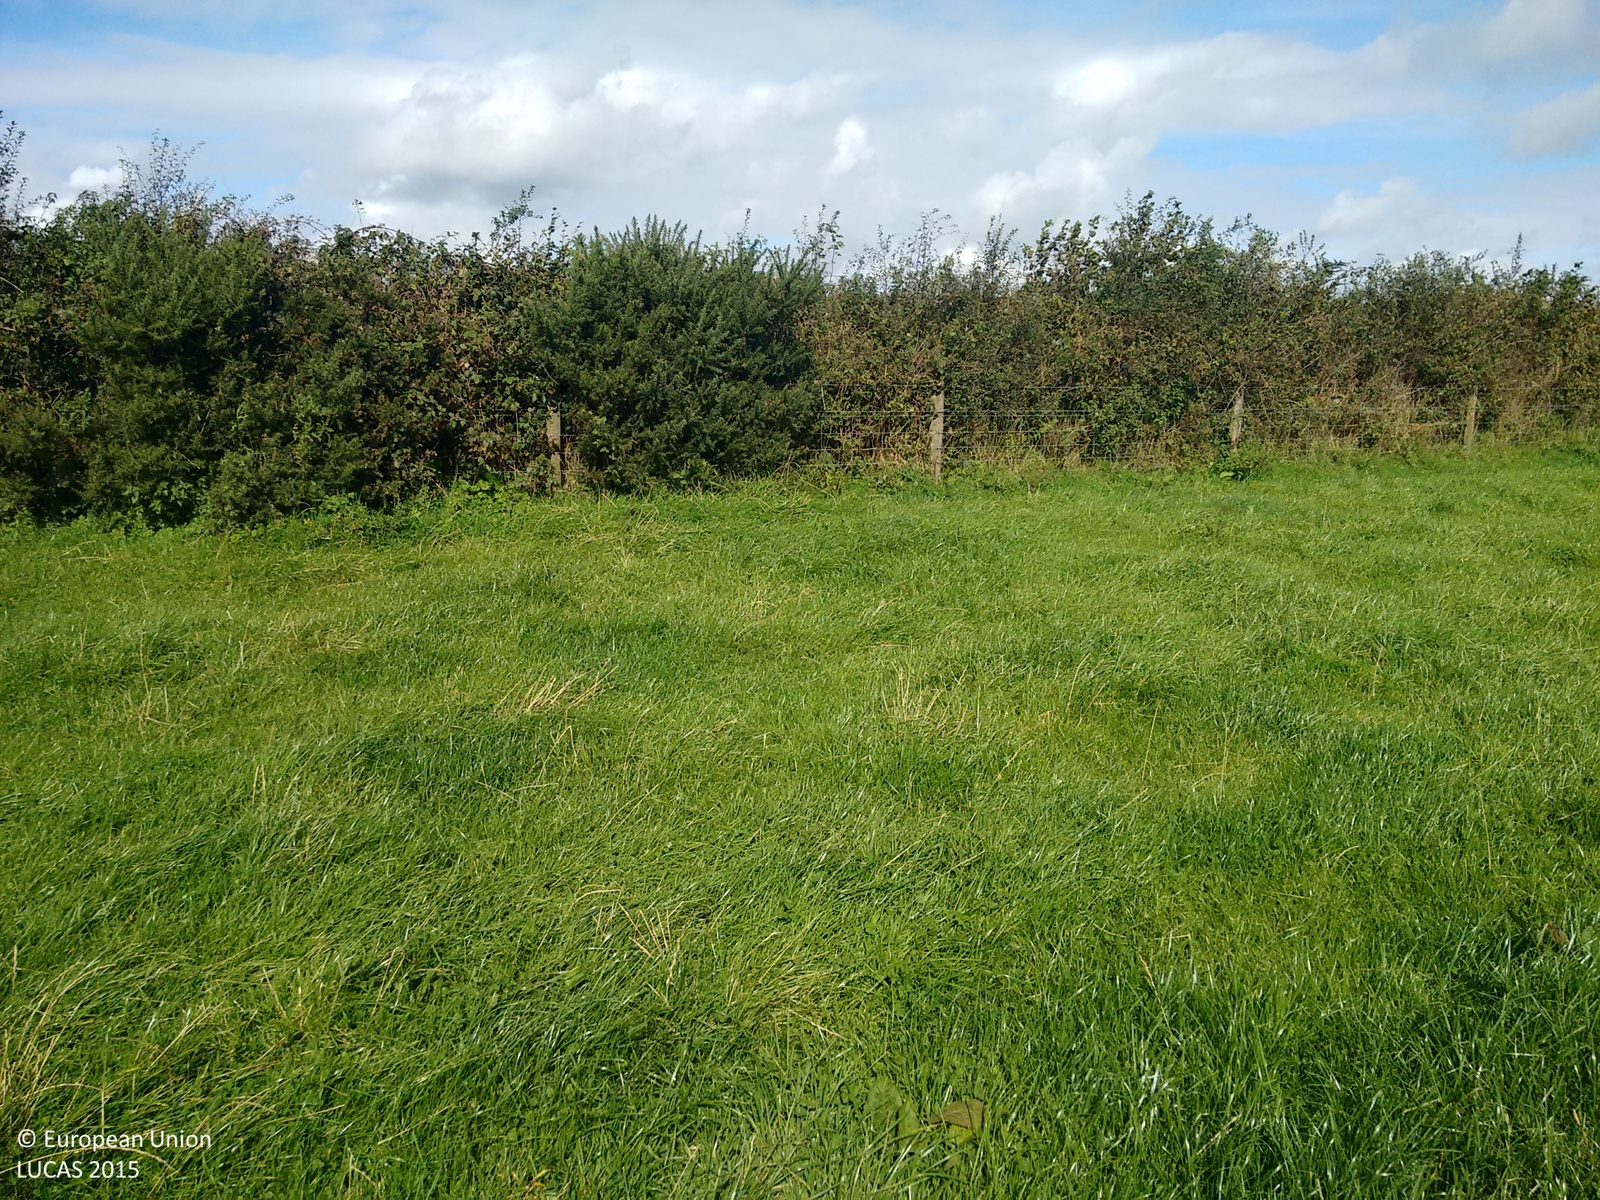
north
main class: Grassland
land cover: Grassland without tree/shrub cover
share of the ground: > 75 %
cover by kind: herbaceous plants 100 %
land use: Agriculture (excluding fallow land and kitchen gardens)
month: September
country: GB
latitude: 50.7330
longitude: -4.1956
